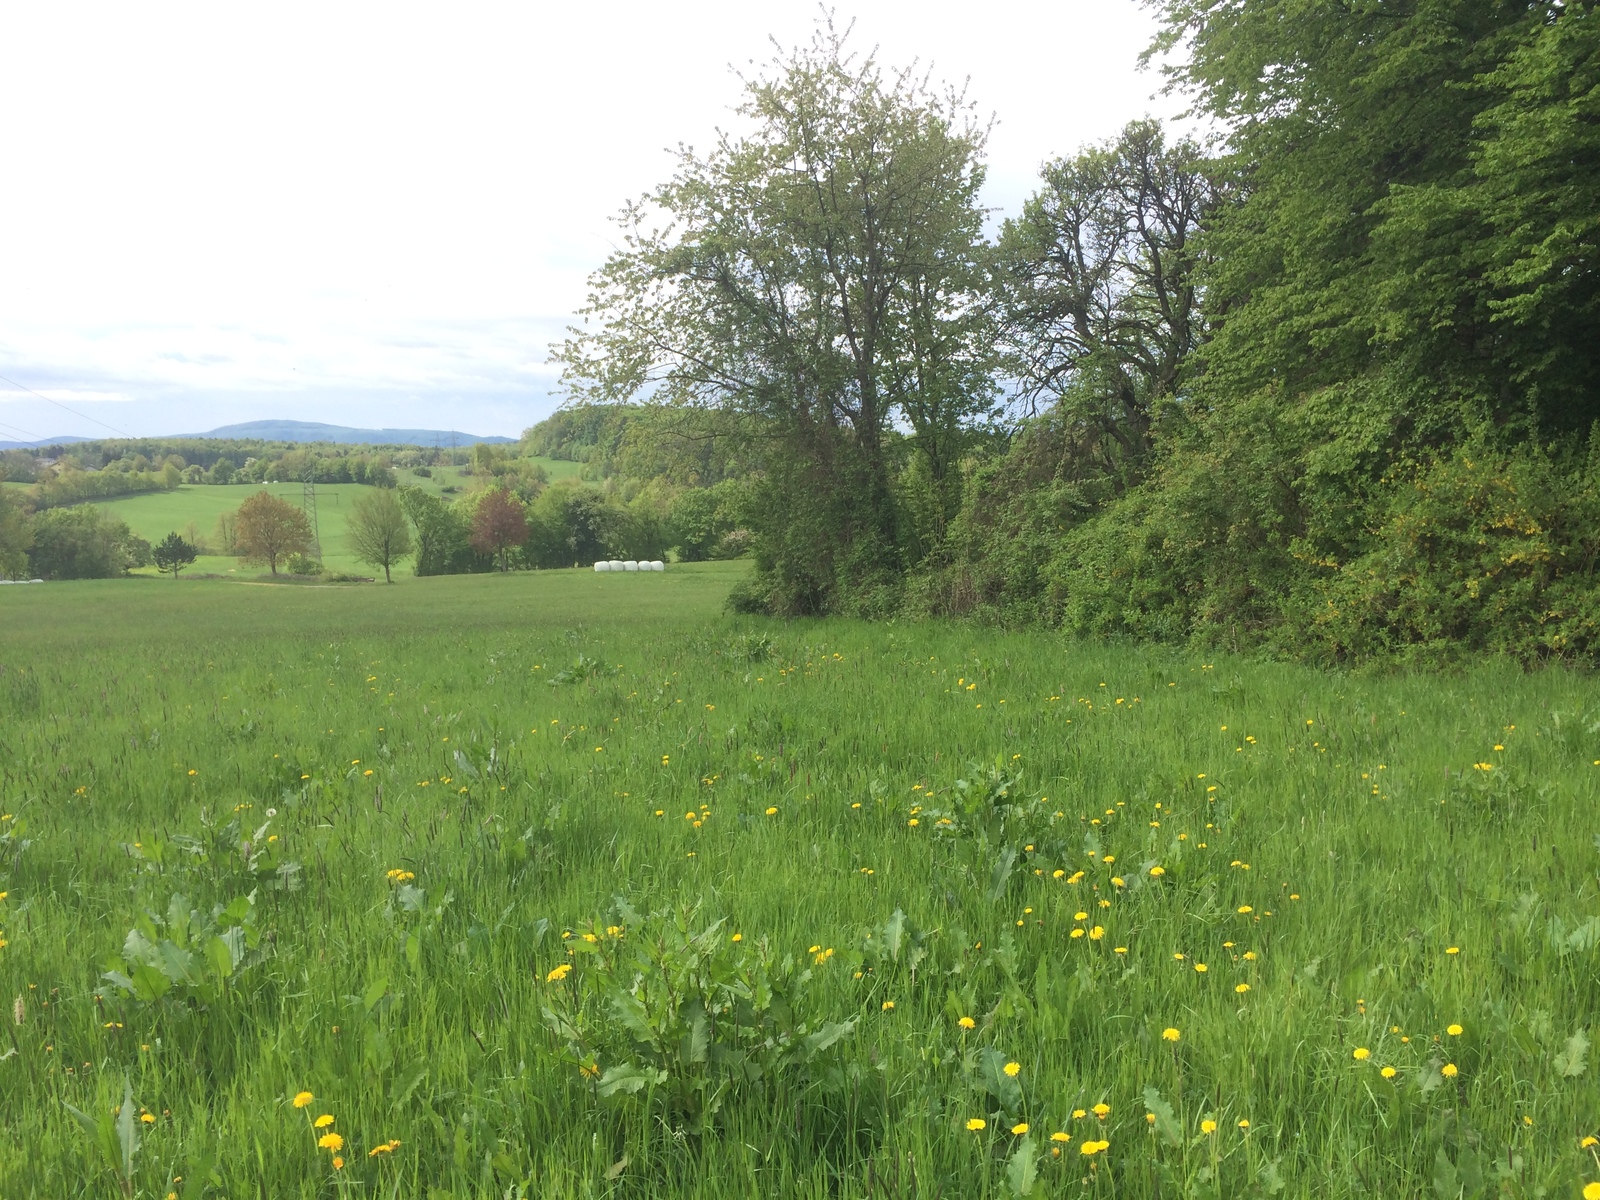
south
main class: Grassland
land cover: Grassland without tree/shrub cover
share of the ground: > 75 %
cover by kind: herbaceous plants 100 %
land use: Agriculture (excluding fallow land and kitchen gardens)
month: May
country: AT
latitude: 48.1259
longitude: 16.1170
